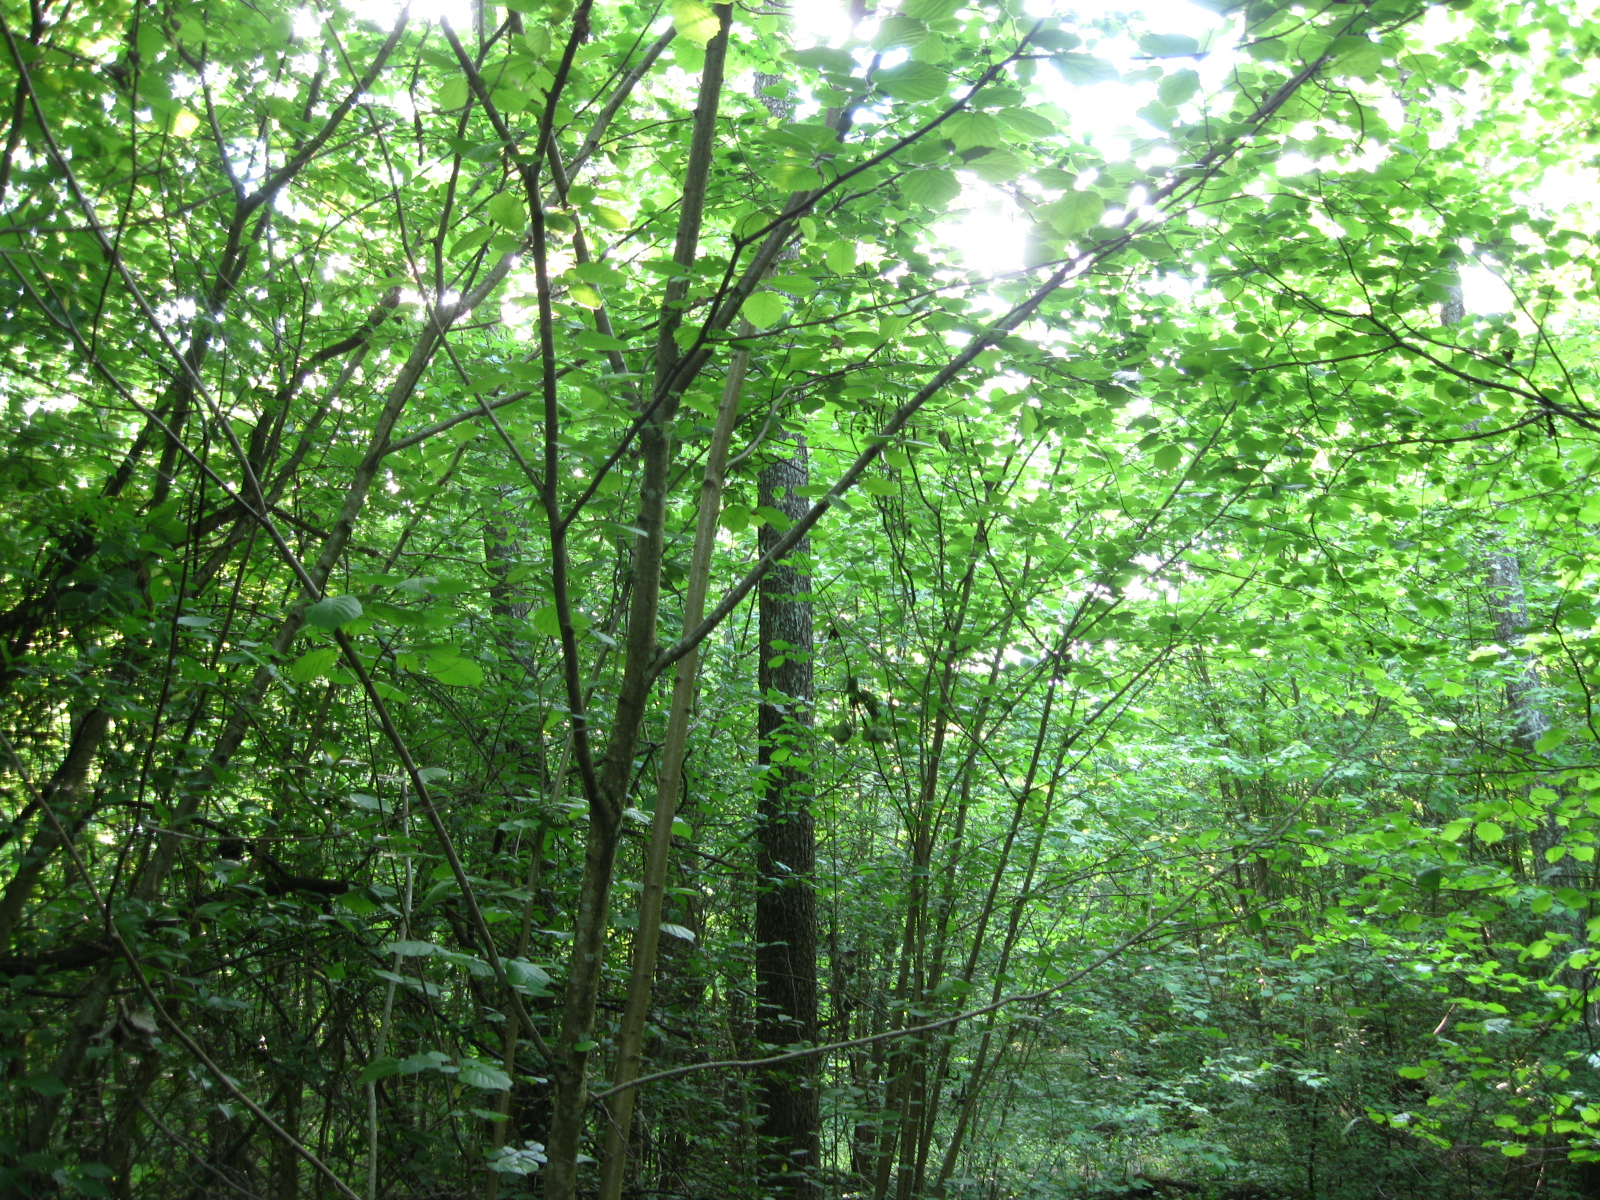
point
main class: Woodland
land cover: Broadleaved woodland
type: non-riverine alder, birch or aspen forest
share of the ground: > 75 %
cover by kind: broadleaved forest trees 90 %, shrubs 5 %, herbaceous plants 5 %
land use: Forestry
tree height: > 5 m
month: June
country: LT
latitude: 55.7904
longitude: 24.0765
